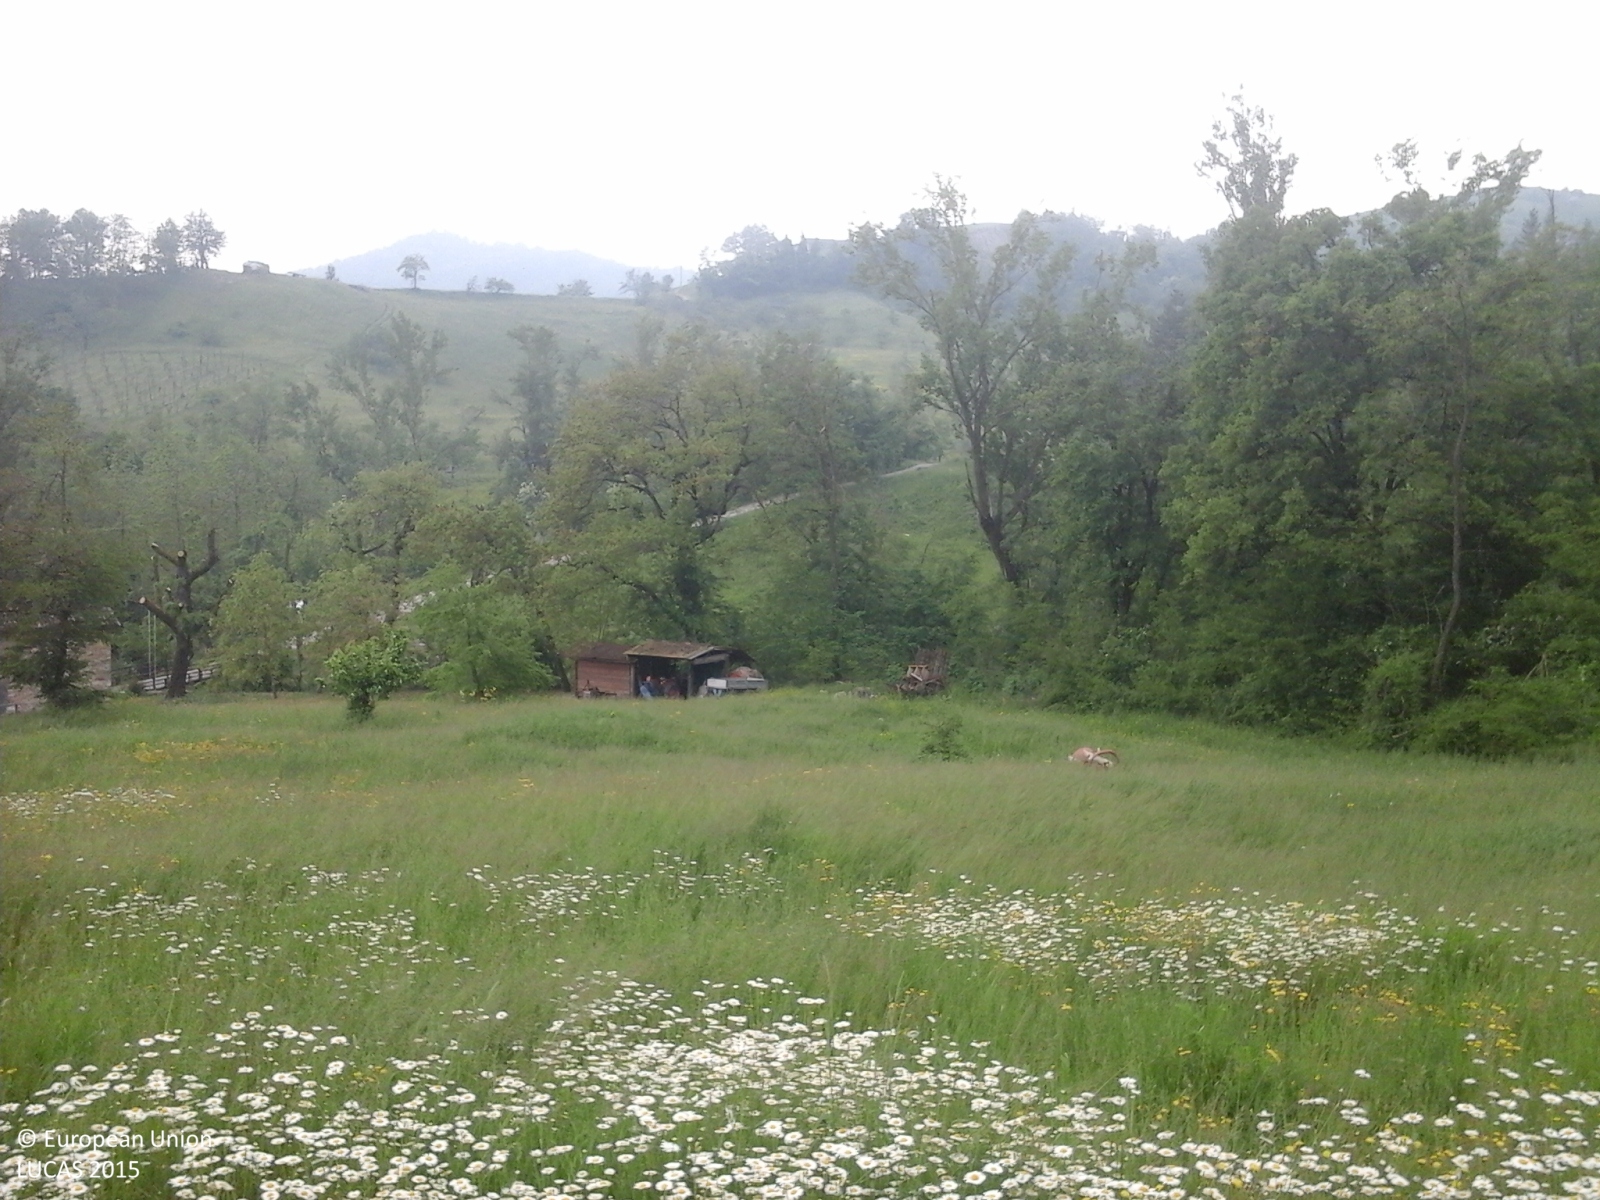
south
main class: Cropland
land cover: Lucerne
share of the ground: 50 - 75 %
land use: Agriculture (excluding fallow land and kitchen gardens)
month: May
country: IT
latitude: 44.3812
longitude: 11.0645
